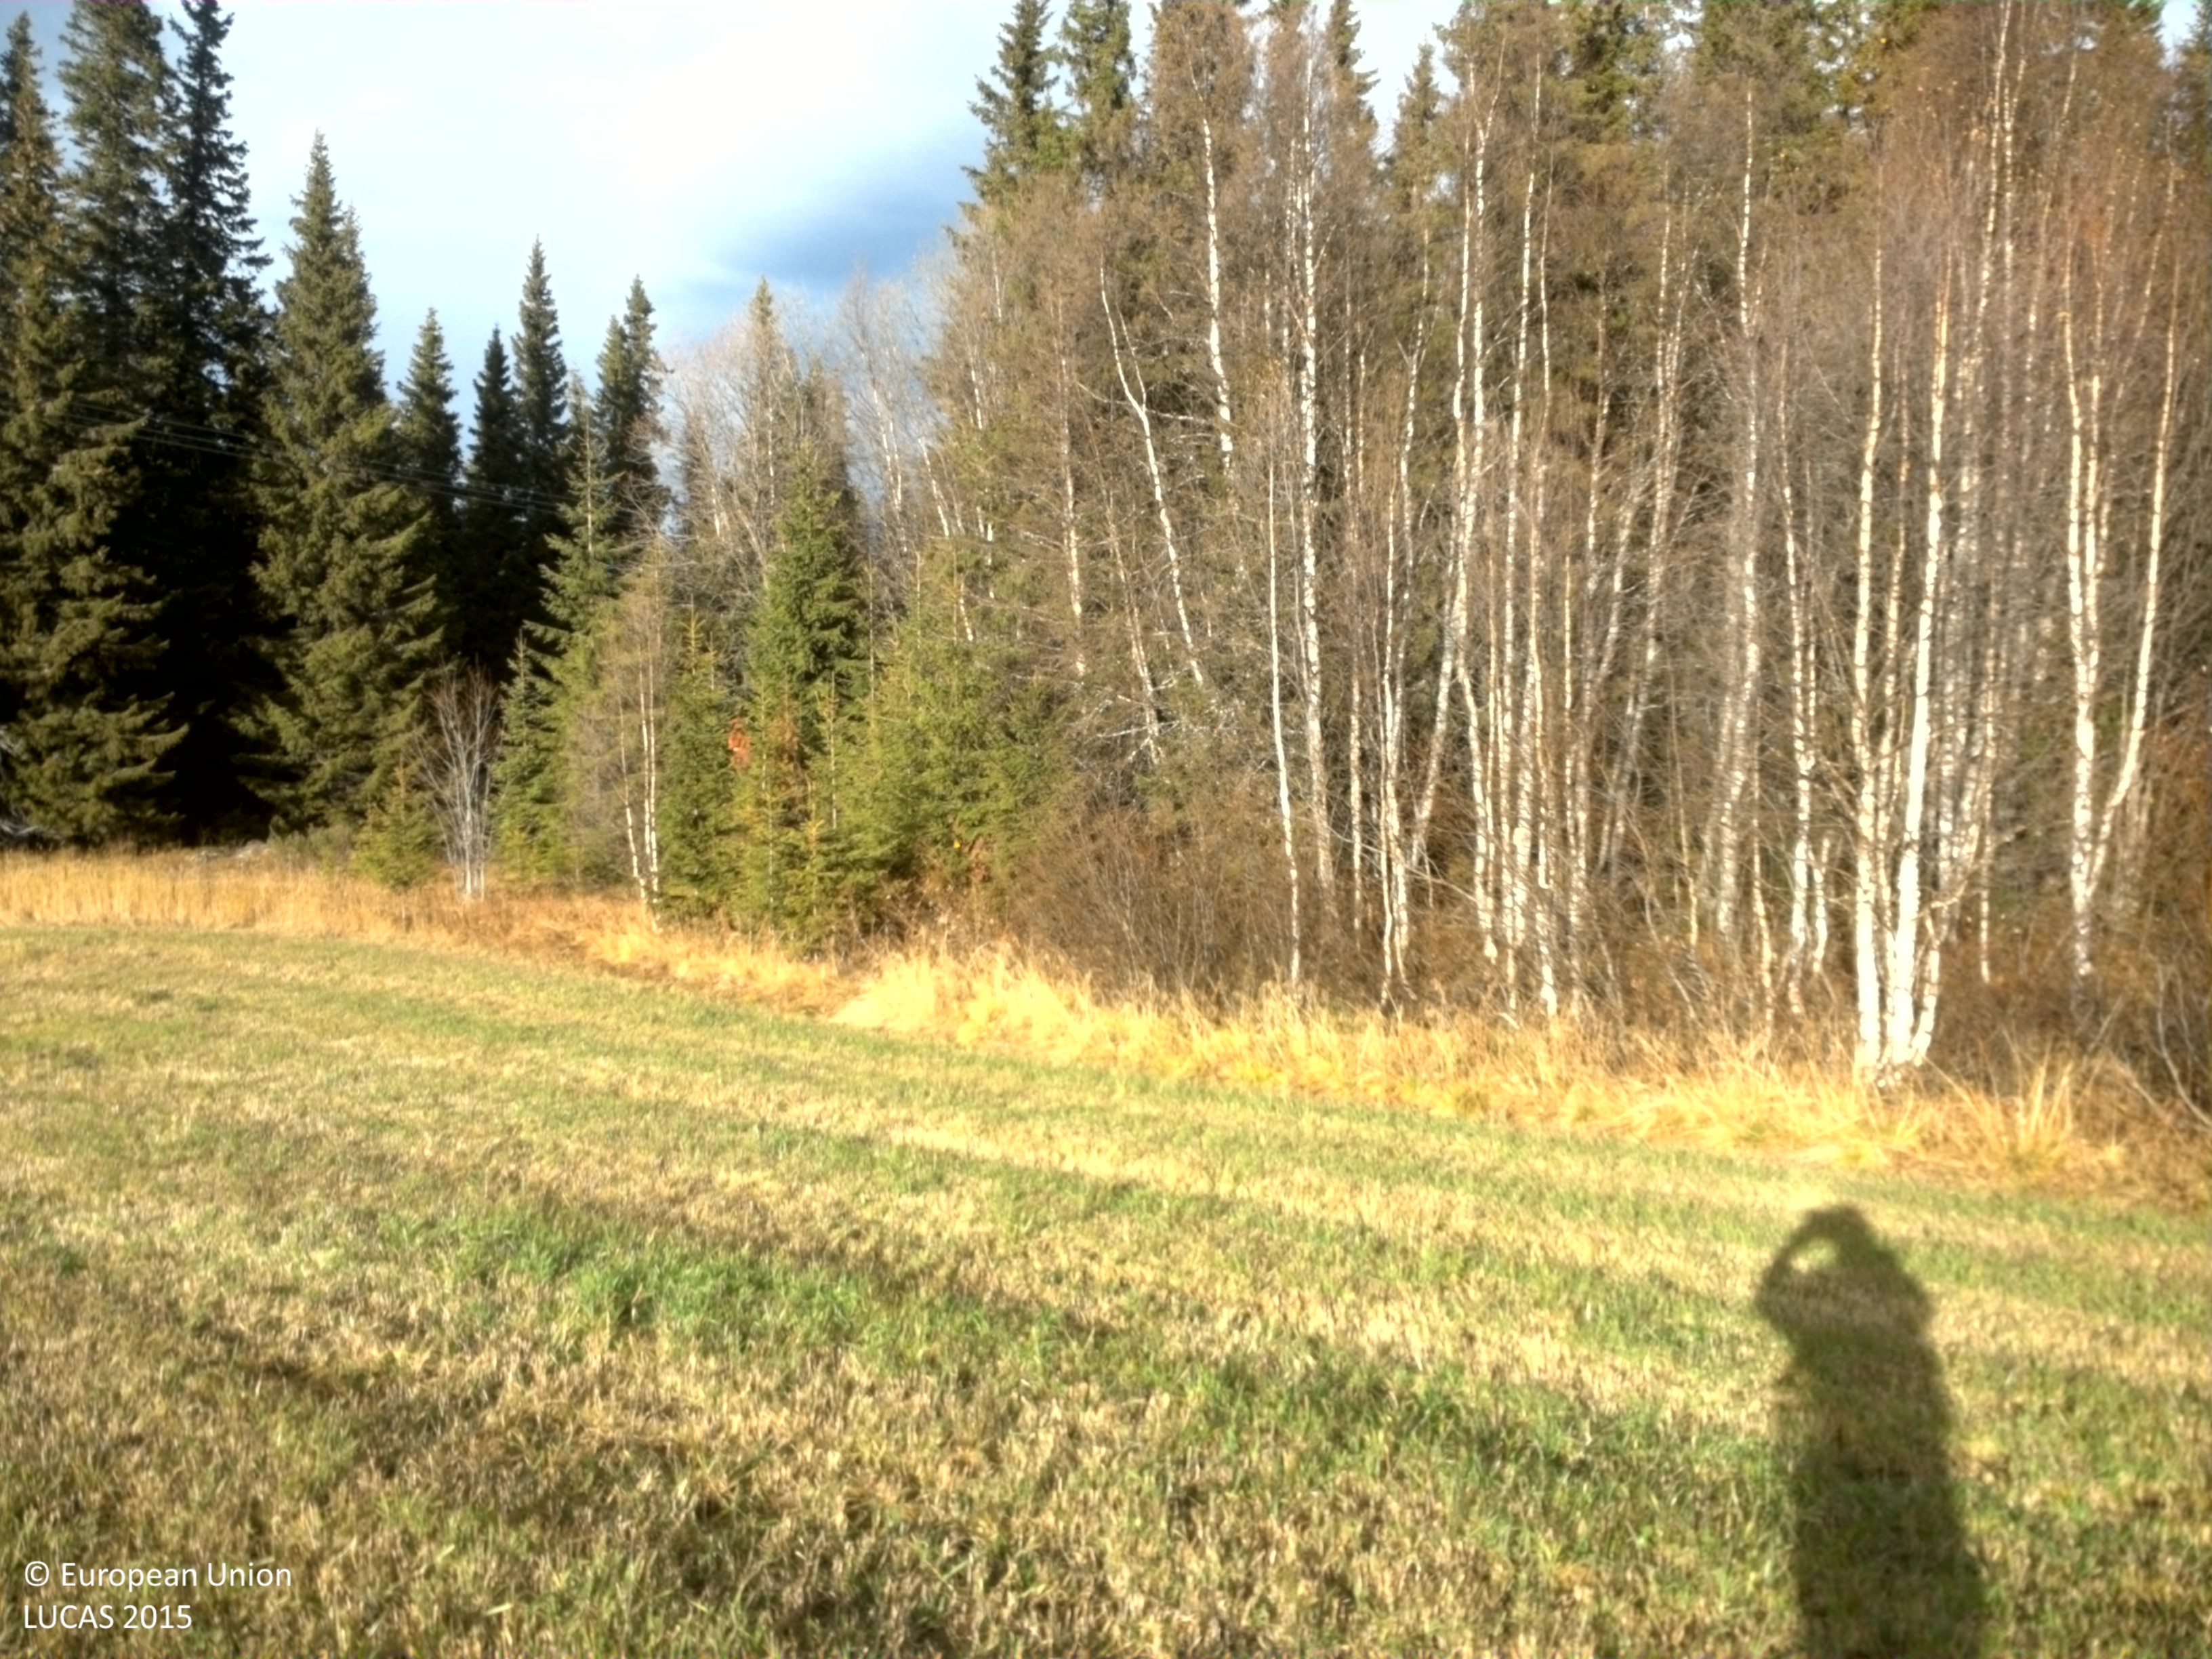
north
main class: Grassland
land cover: Grassland without tree/shrub cover
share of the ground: > 75 %
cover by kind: herbaceous plants 100 %
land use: Agriculture (excluding fallow land and kitchen gardens)
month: October
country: SE
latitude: 64.5405
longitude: 16.4102
